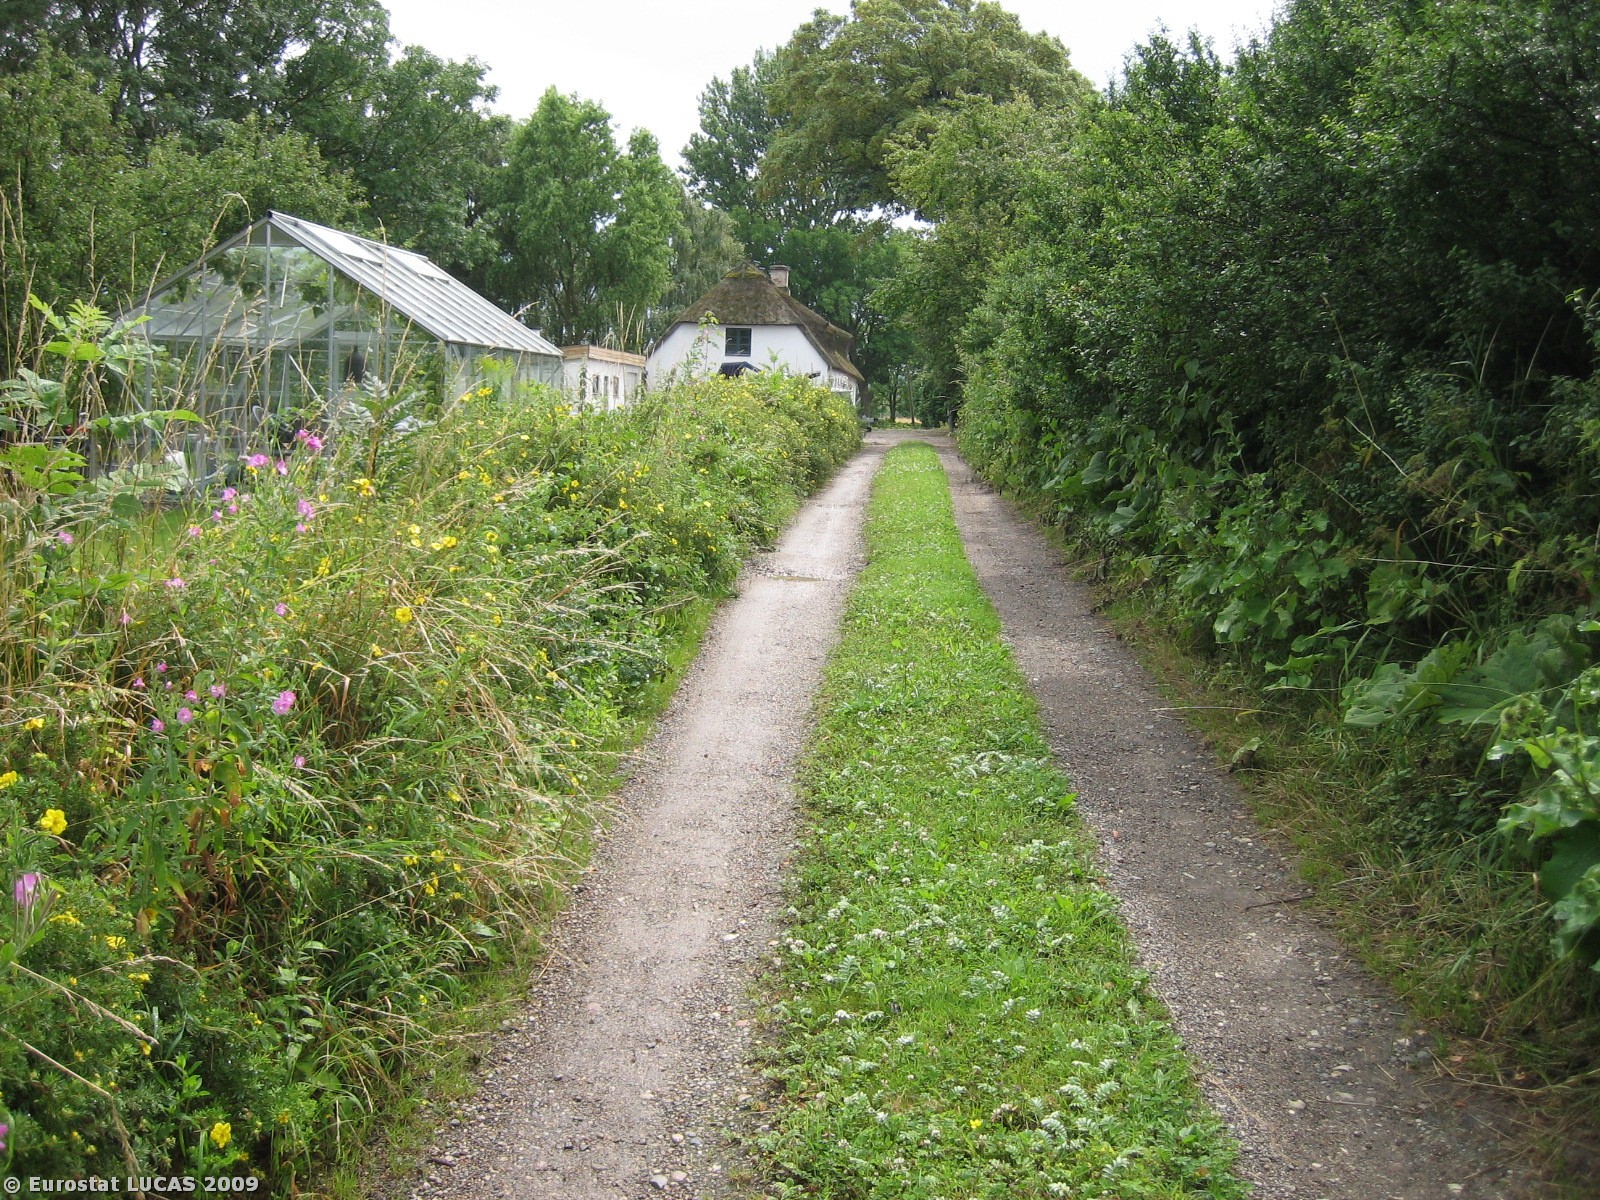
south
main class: Woodland
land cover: Broadleaved woodland
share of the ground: > 75 %
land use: Residential
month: July
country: DK
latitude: 55.3249
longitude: 9.9213
